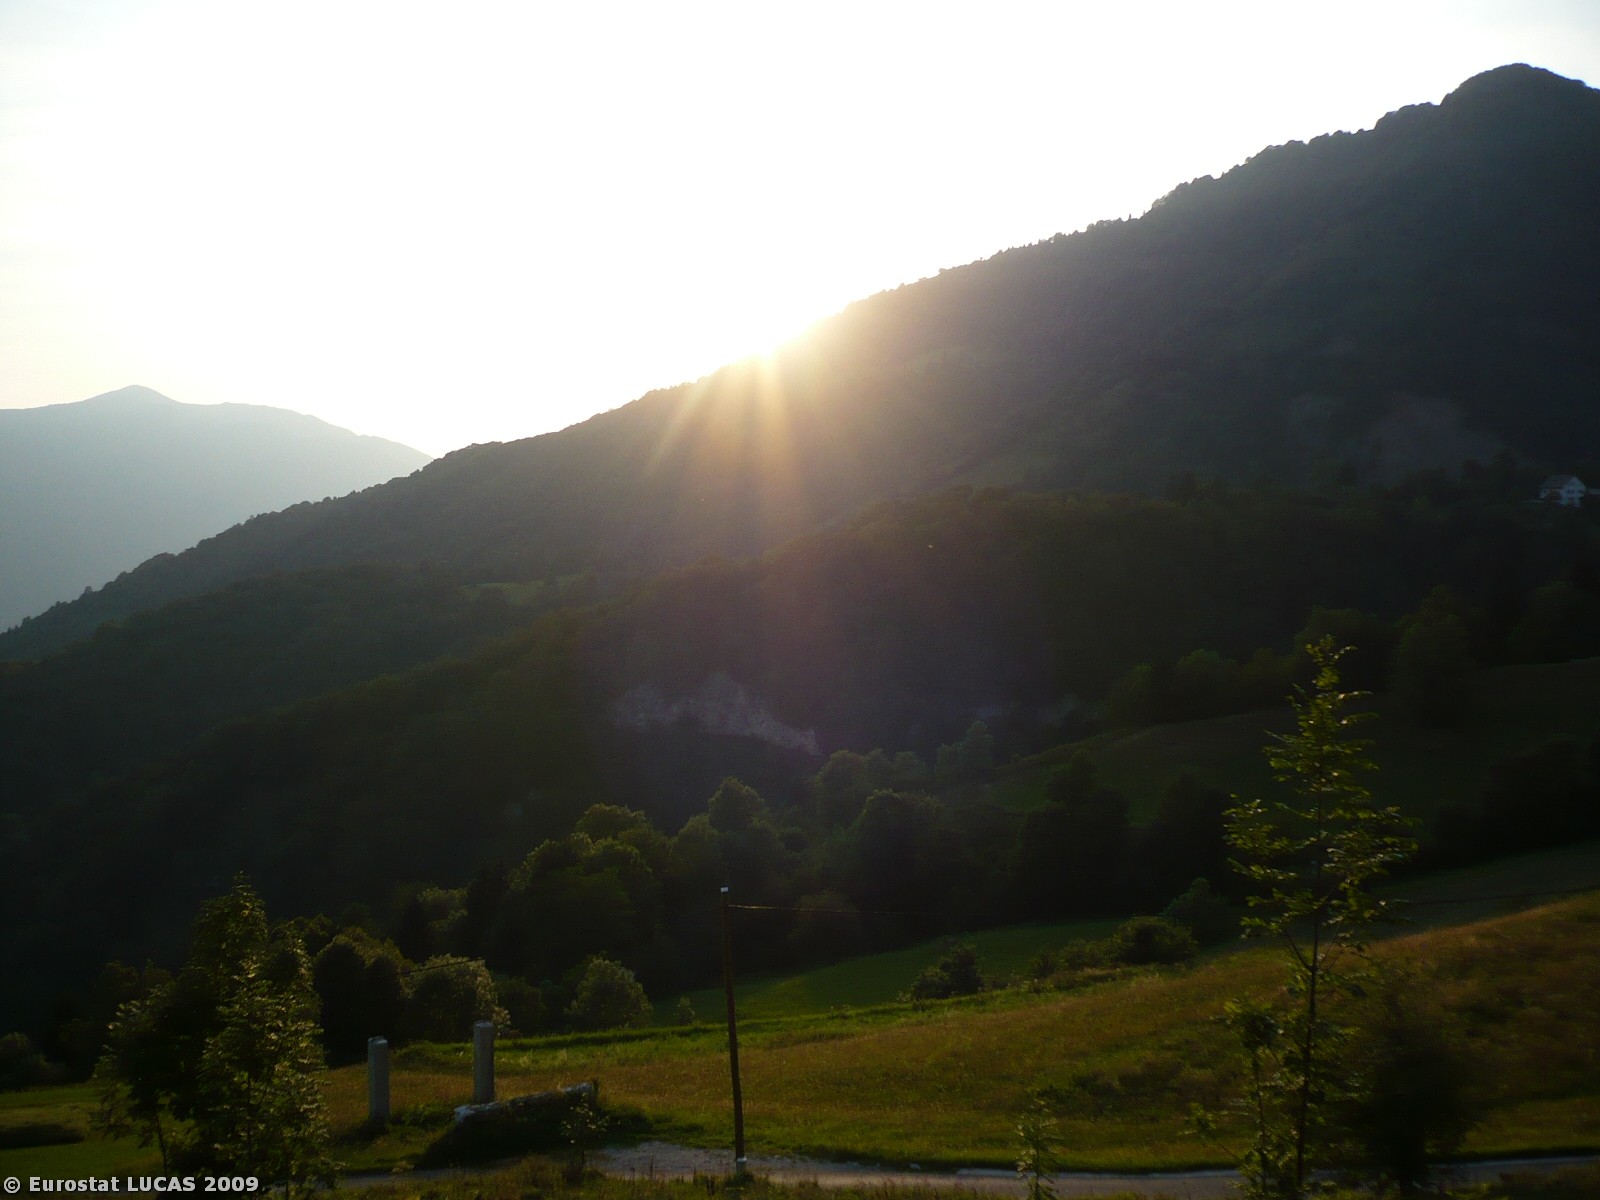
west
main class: Grassland
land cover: Grassland with sparse tree/shrub cover
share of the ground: > 75 %
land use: Fallow land
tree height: > 5 m
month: August
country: SI
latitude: 46.2343
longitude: 13.6663
